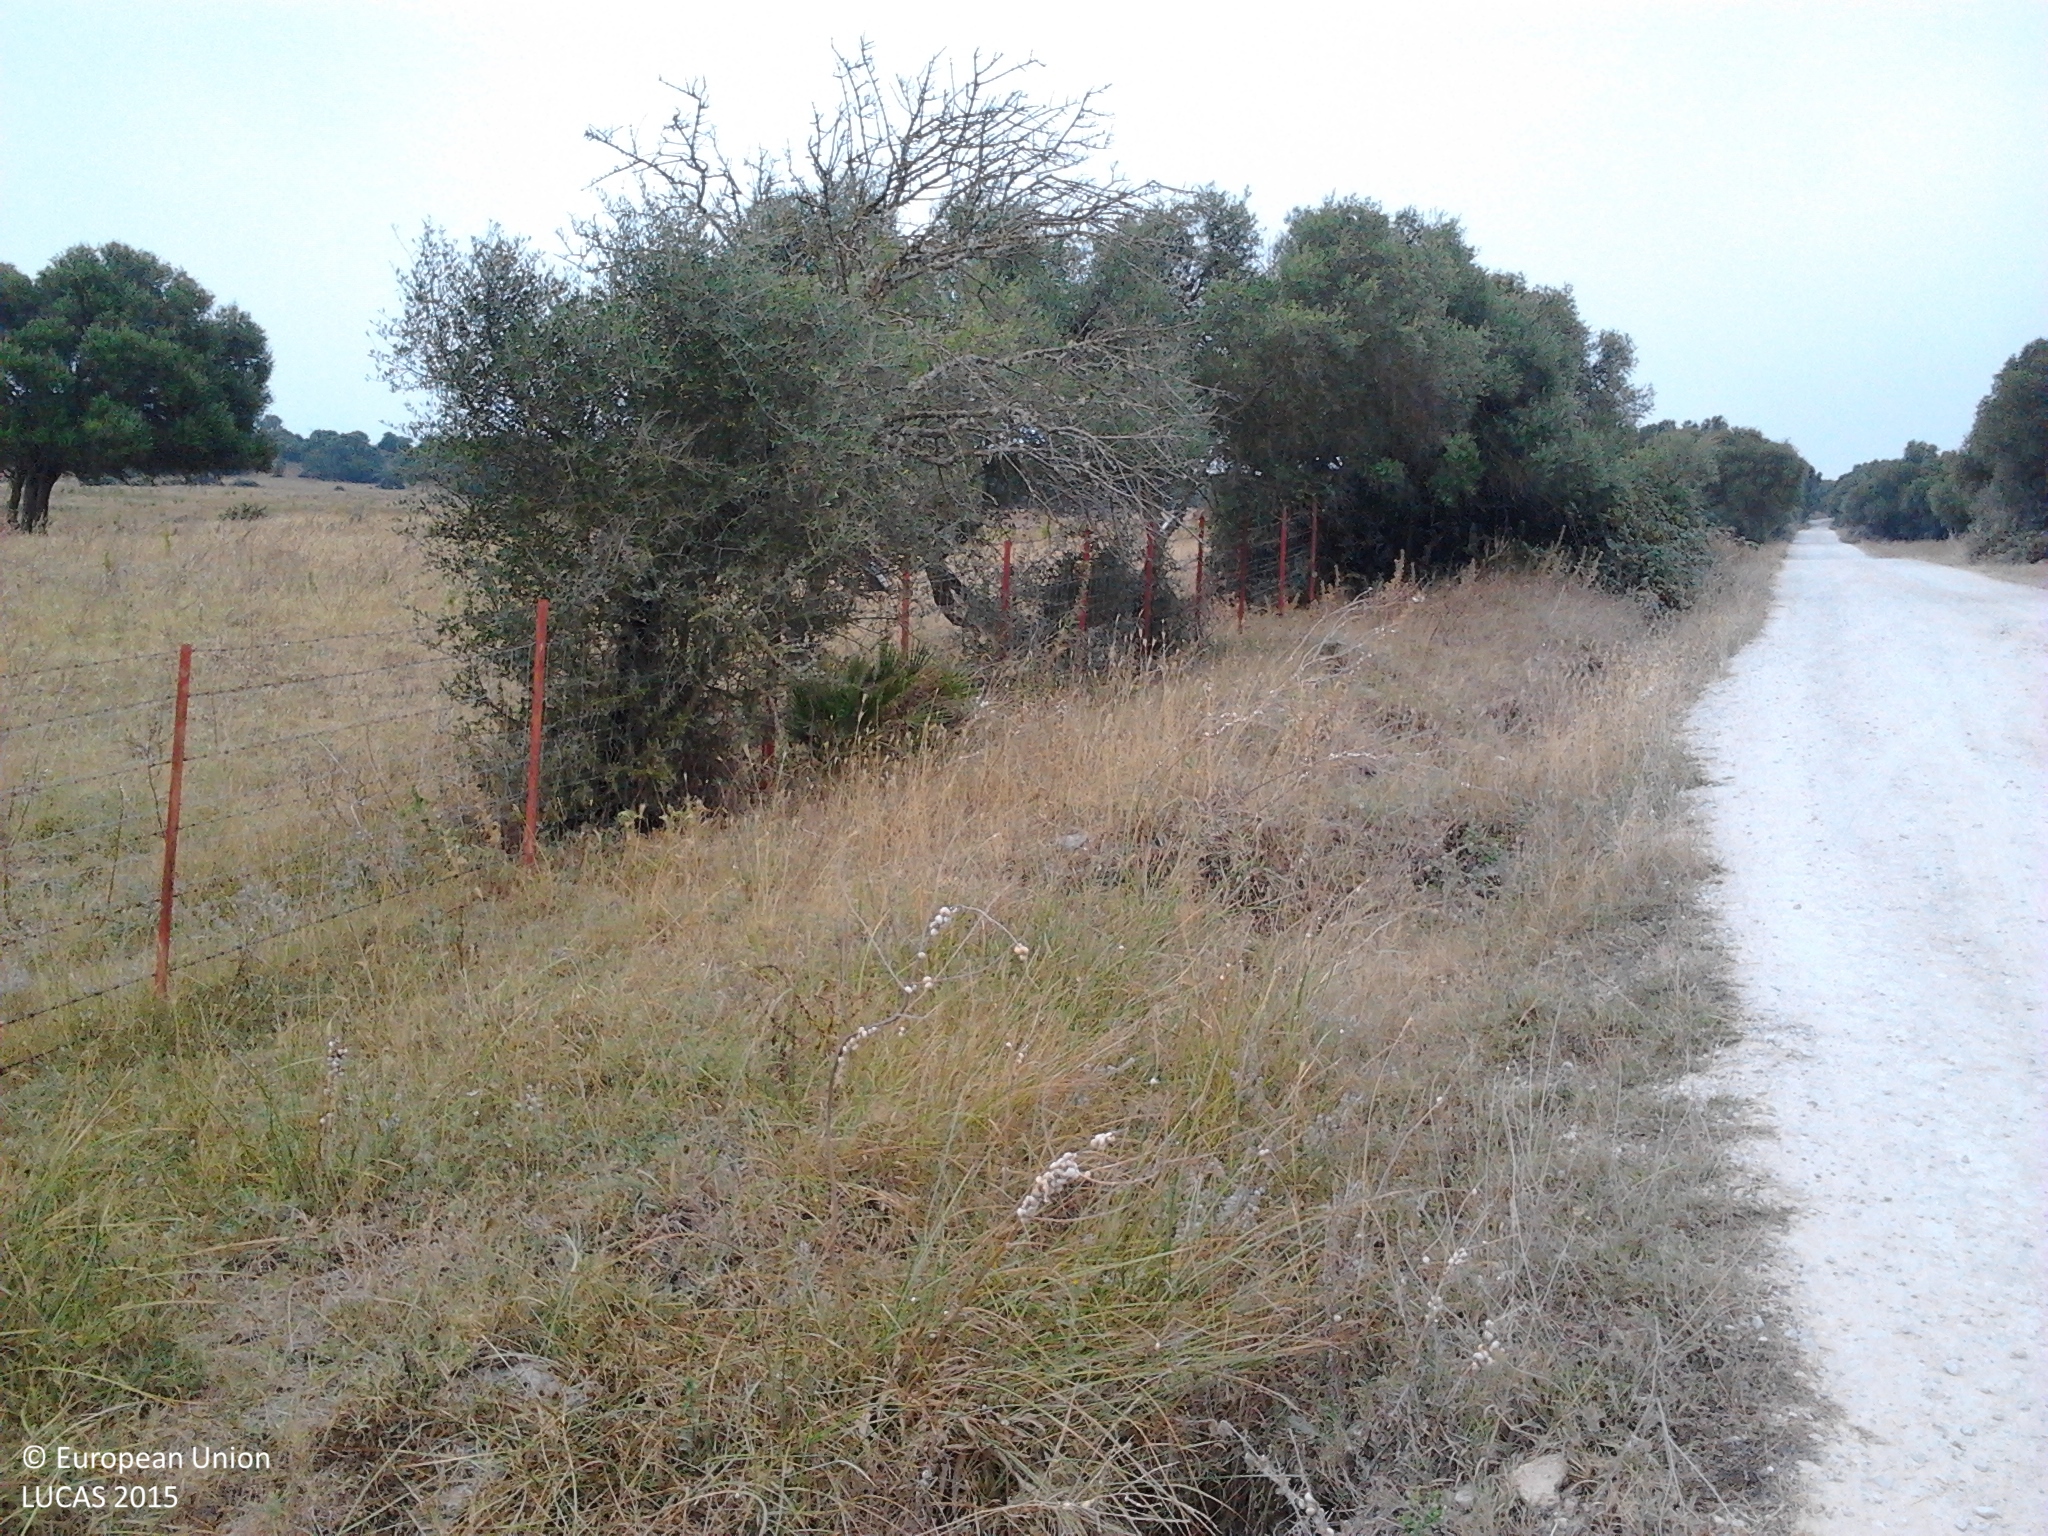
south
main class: Grassland
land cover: Grassland without tree/shrub cover
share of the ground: > 75 %
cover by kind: herbaceous plants 100 %
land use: Agriculture (excluding fallow land and kitchen gardens)
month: July
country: ES
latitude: 36.3561
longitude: -5.8363
